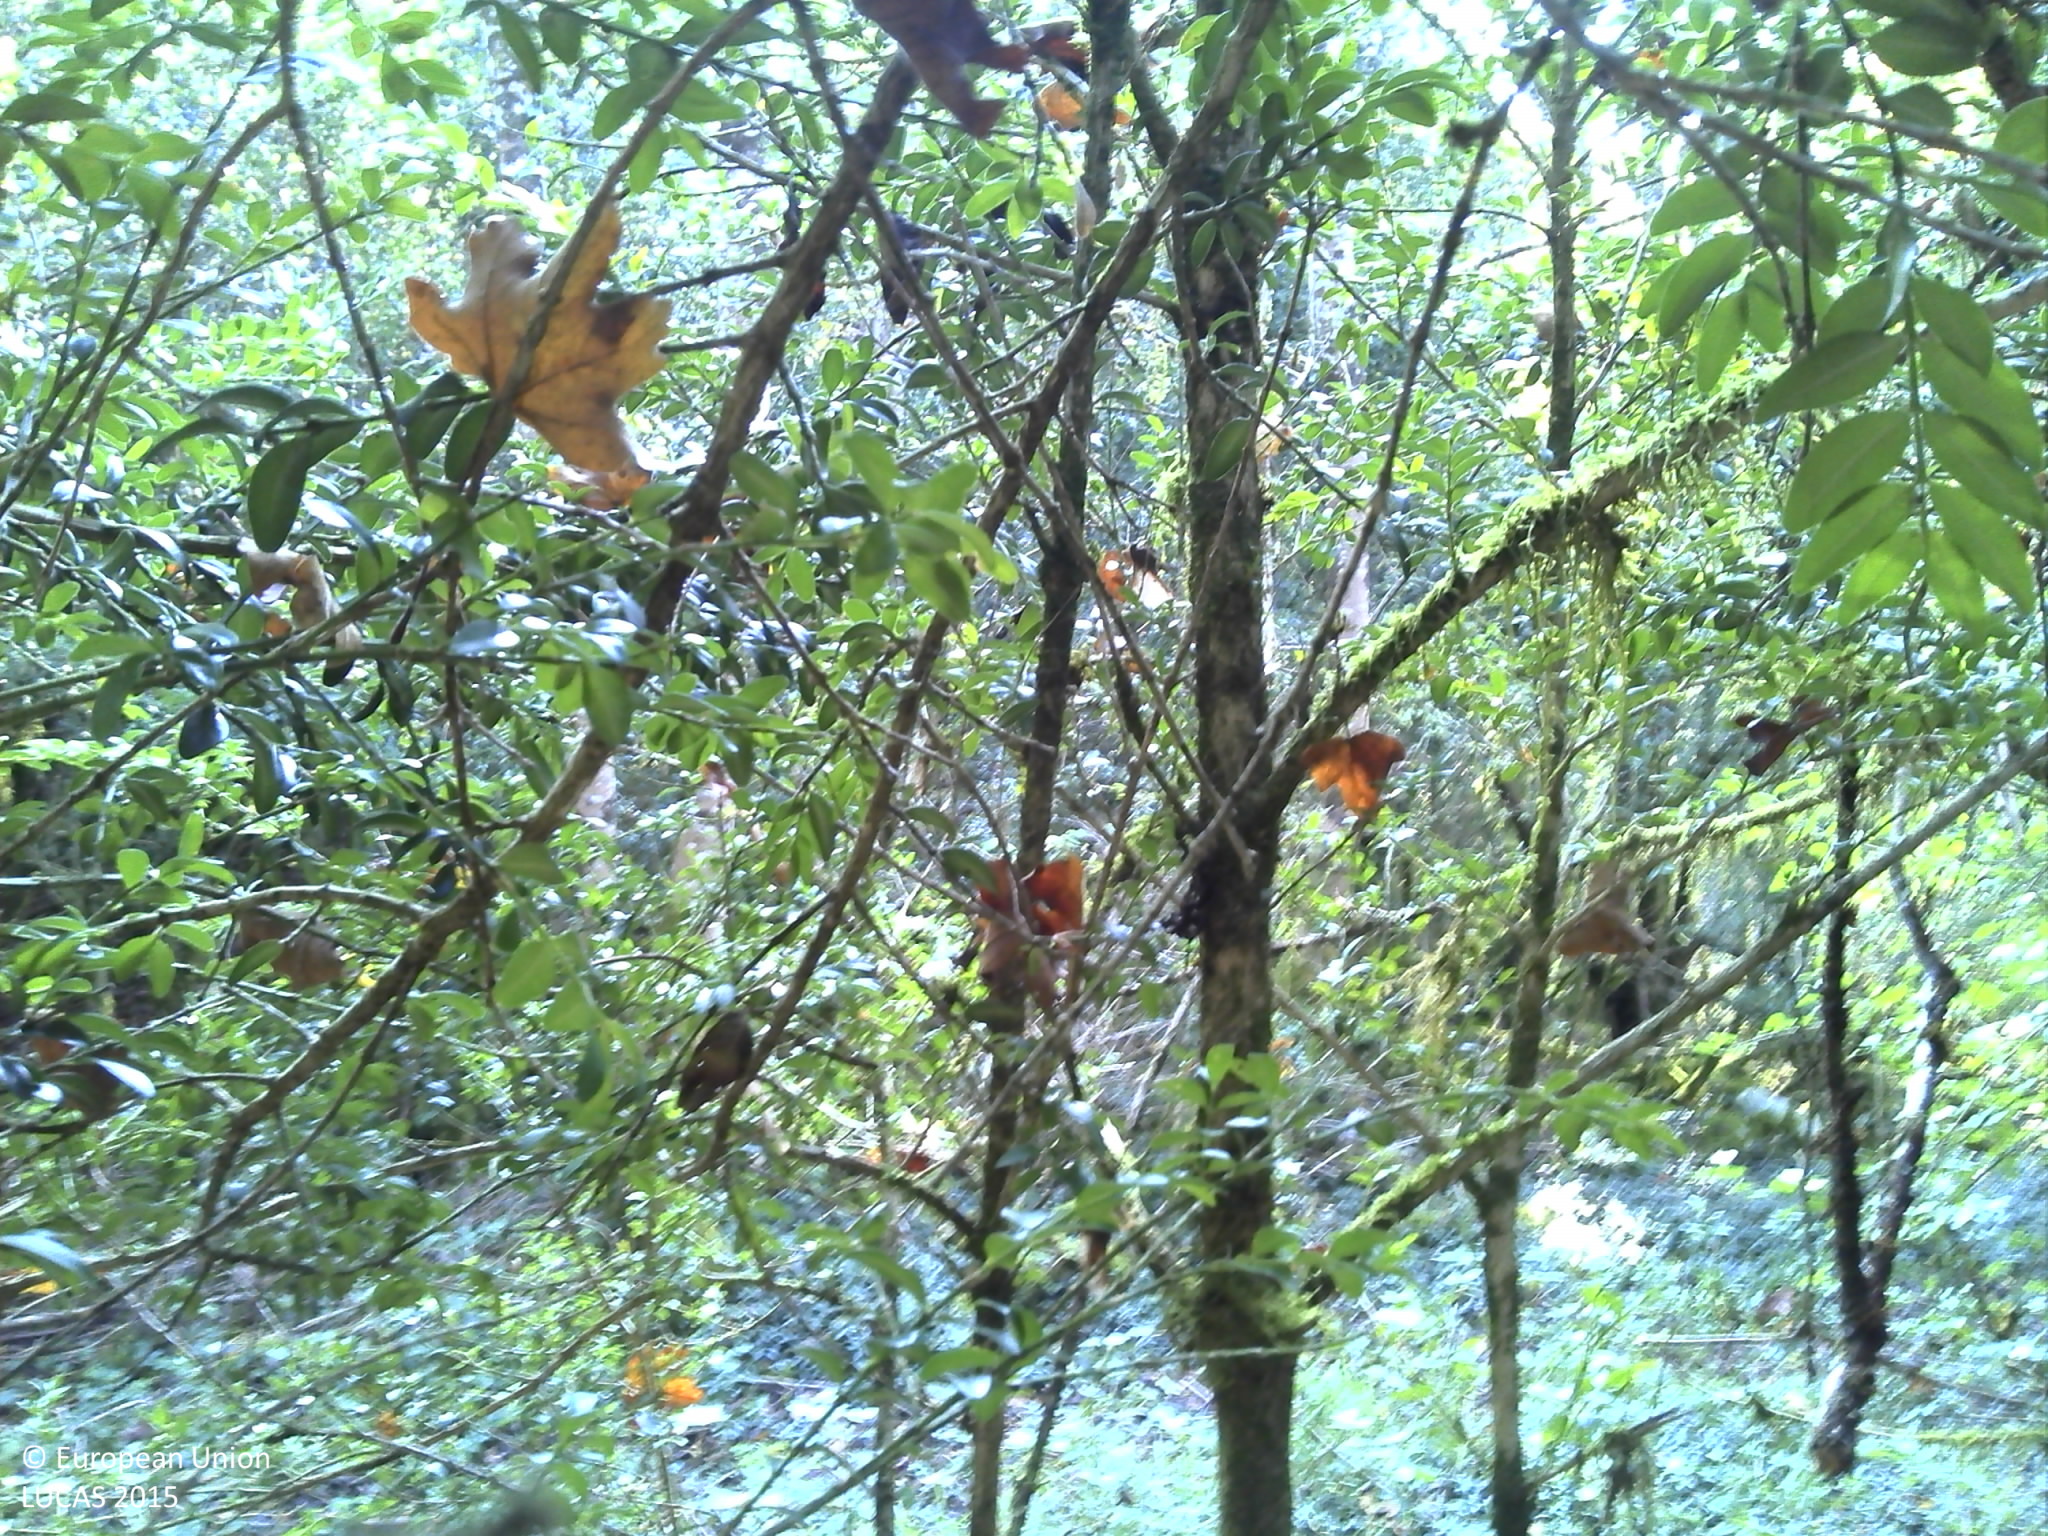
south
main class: Woodland
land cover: Broadleaved woodland
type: mesophytic deciduous forest
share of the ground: > 75 %
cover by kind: broadleaved forest trees 90 %, consolidated bare surface 5 %, unconsolidated bare surface 5 %
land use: Semi-natural and natural areas not in use
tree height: > 5 m
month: October
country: FR
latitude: 46.1623
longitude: 5.4058
